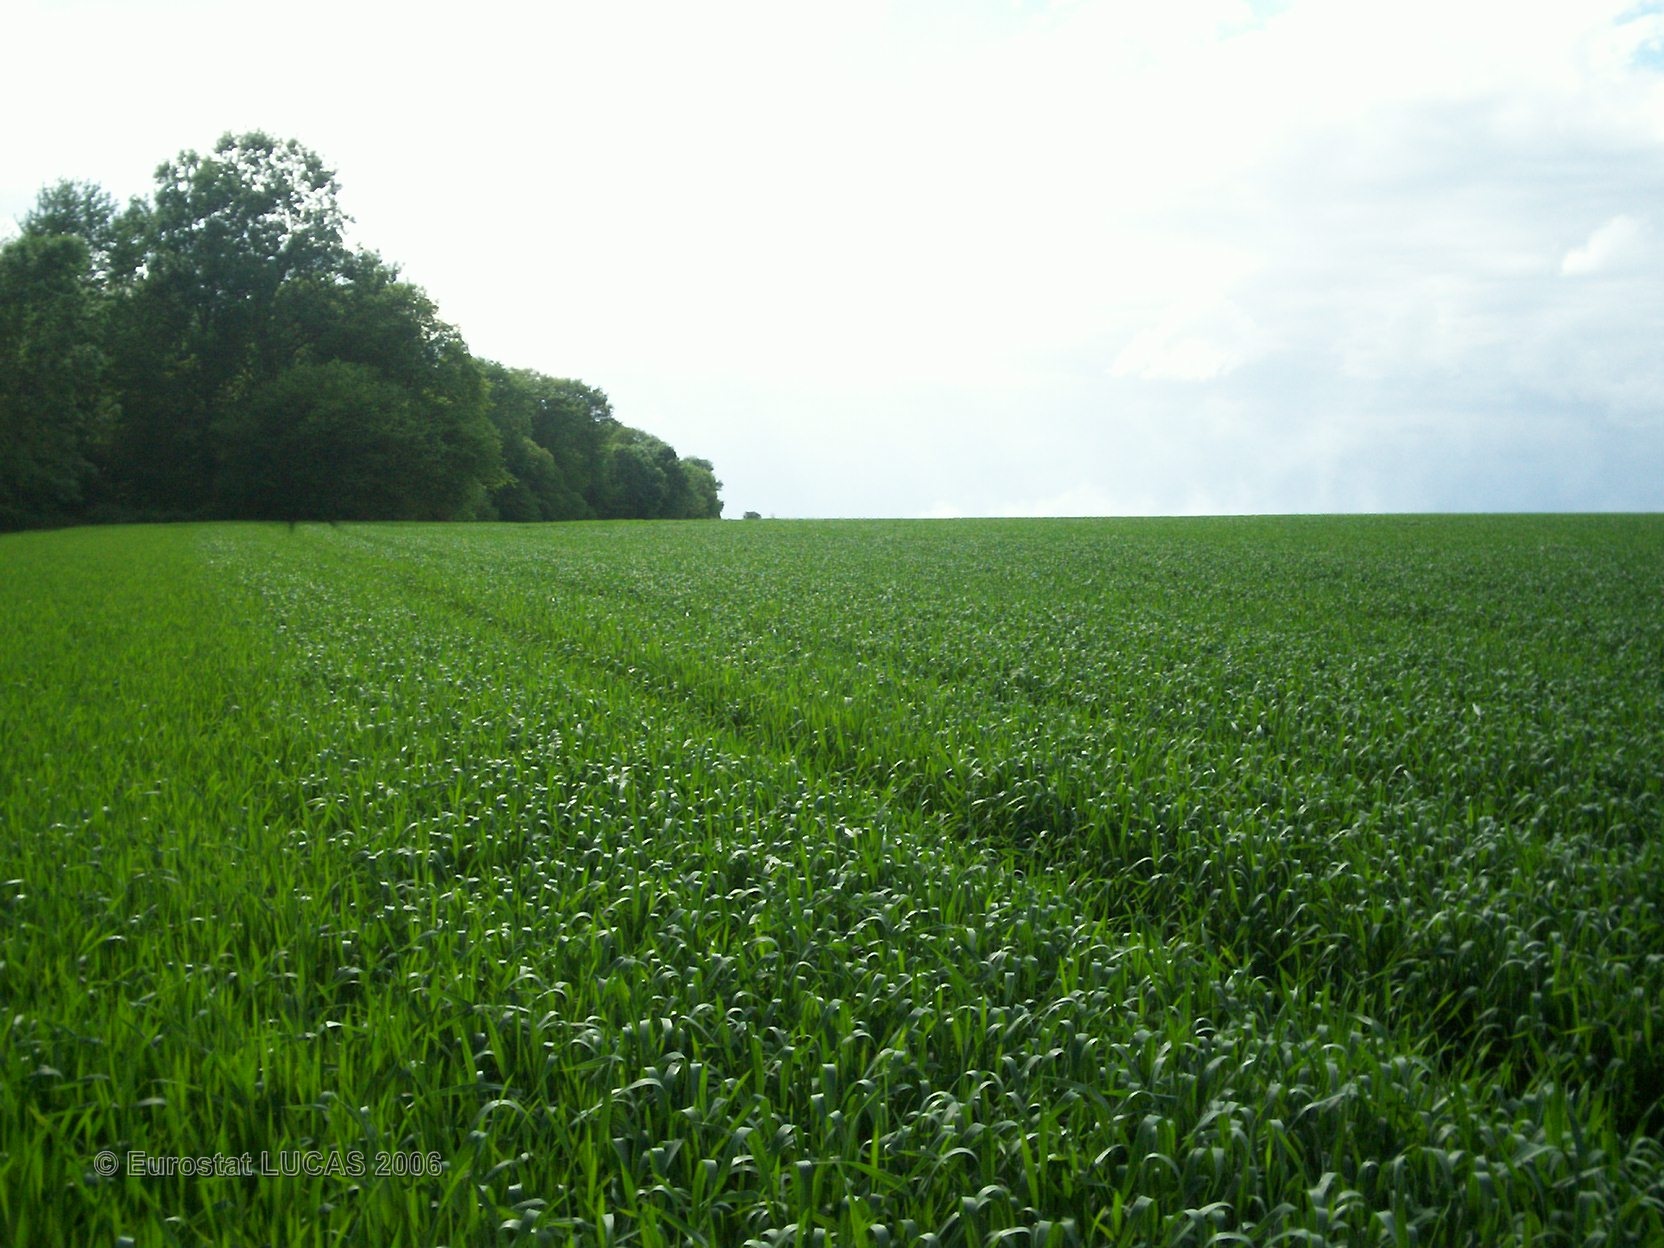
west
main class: Cropland
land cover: Common wheat
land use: Agriculture (excluding fallow land and kitchen gardens)
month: May
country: FR
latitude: 49.3891
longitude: 0.5089
